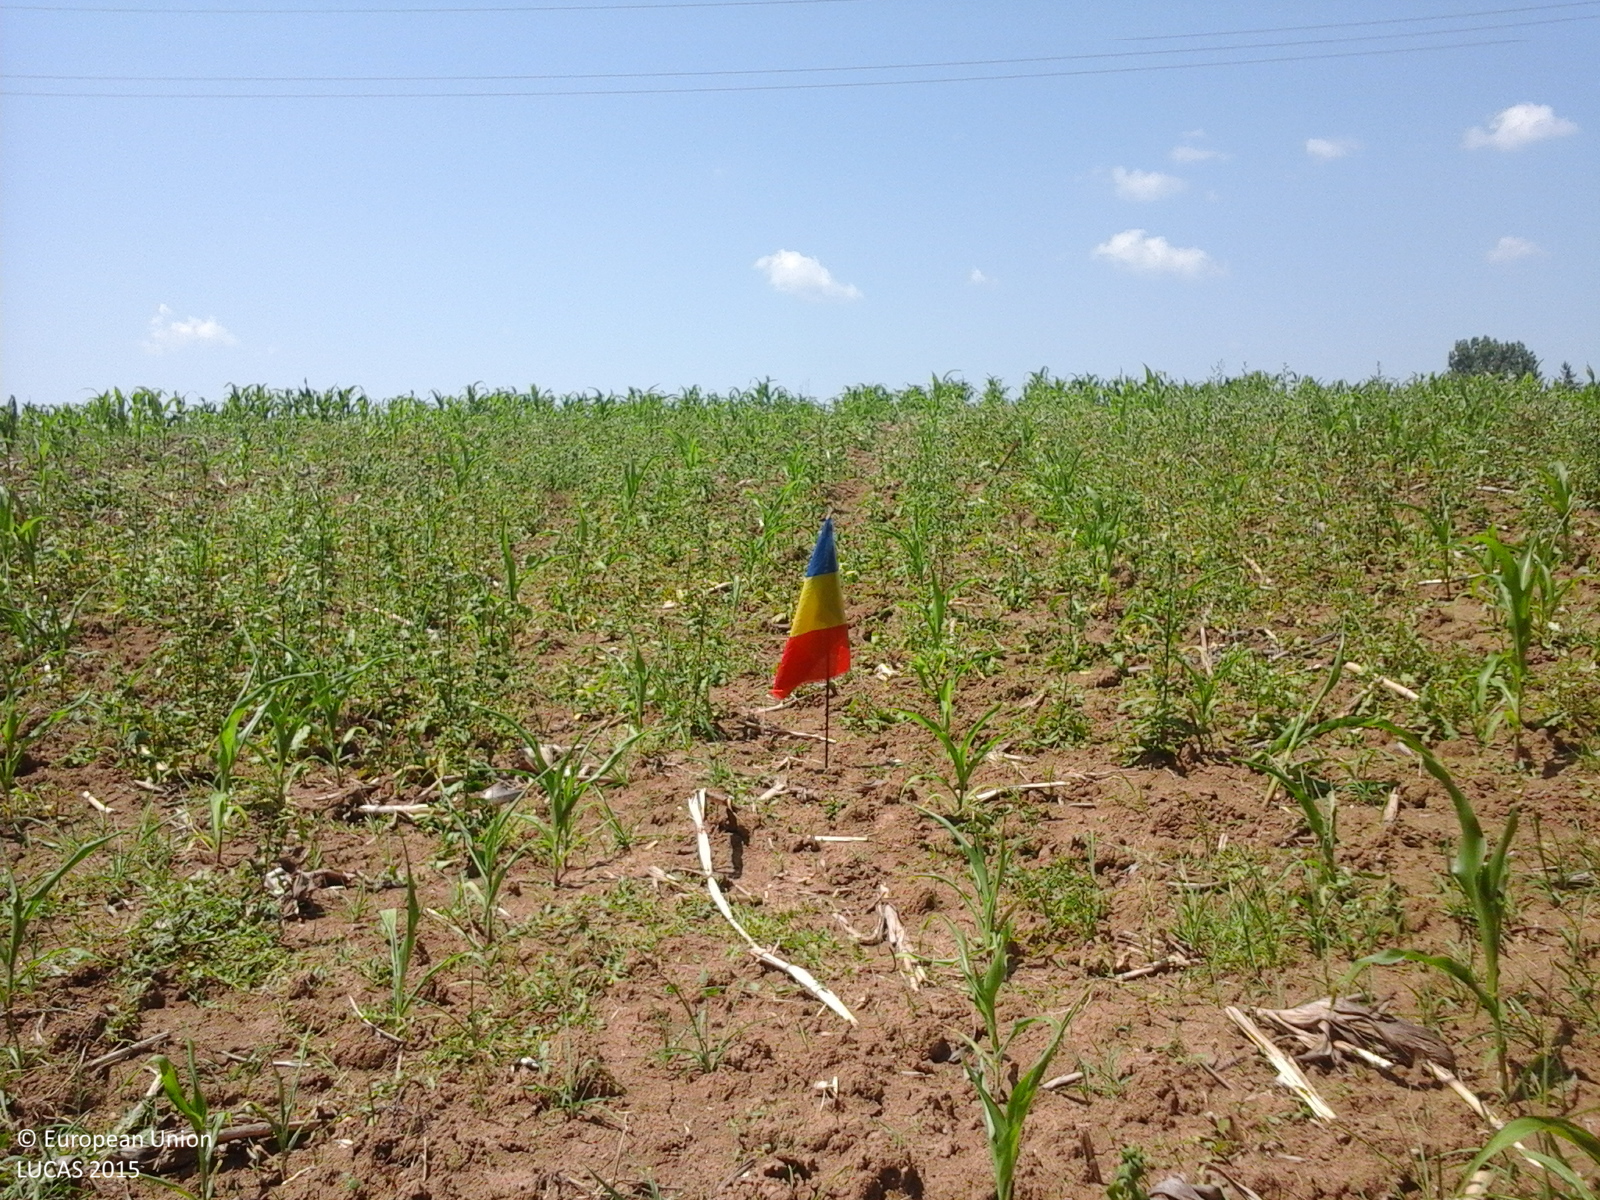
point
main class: Cropland
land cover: Maize
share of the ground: 10 - 25 %
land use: Agriculture (excluding fallow land and kitchen gardens)
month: July
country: RO
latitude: 44.8715
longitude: 24.5686
